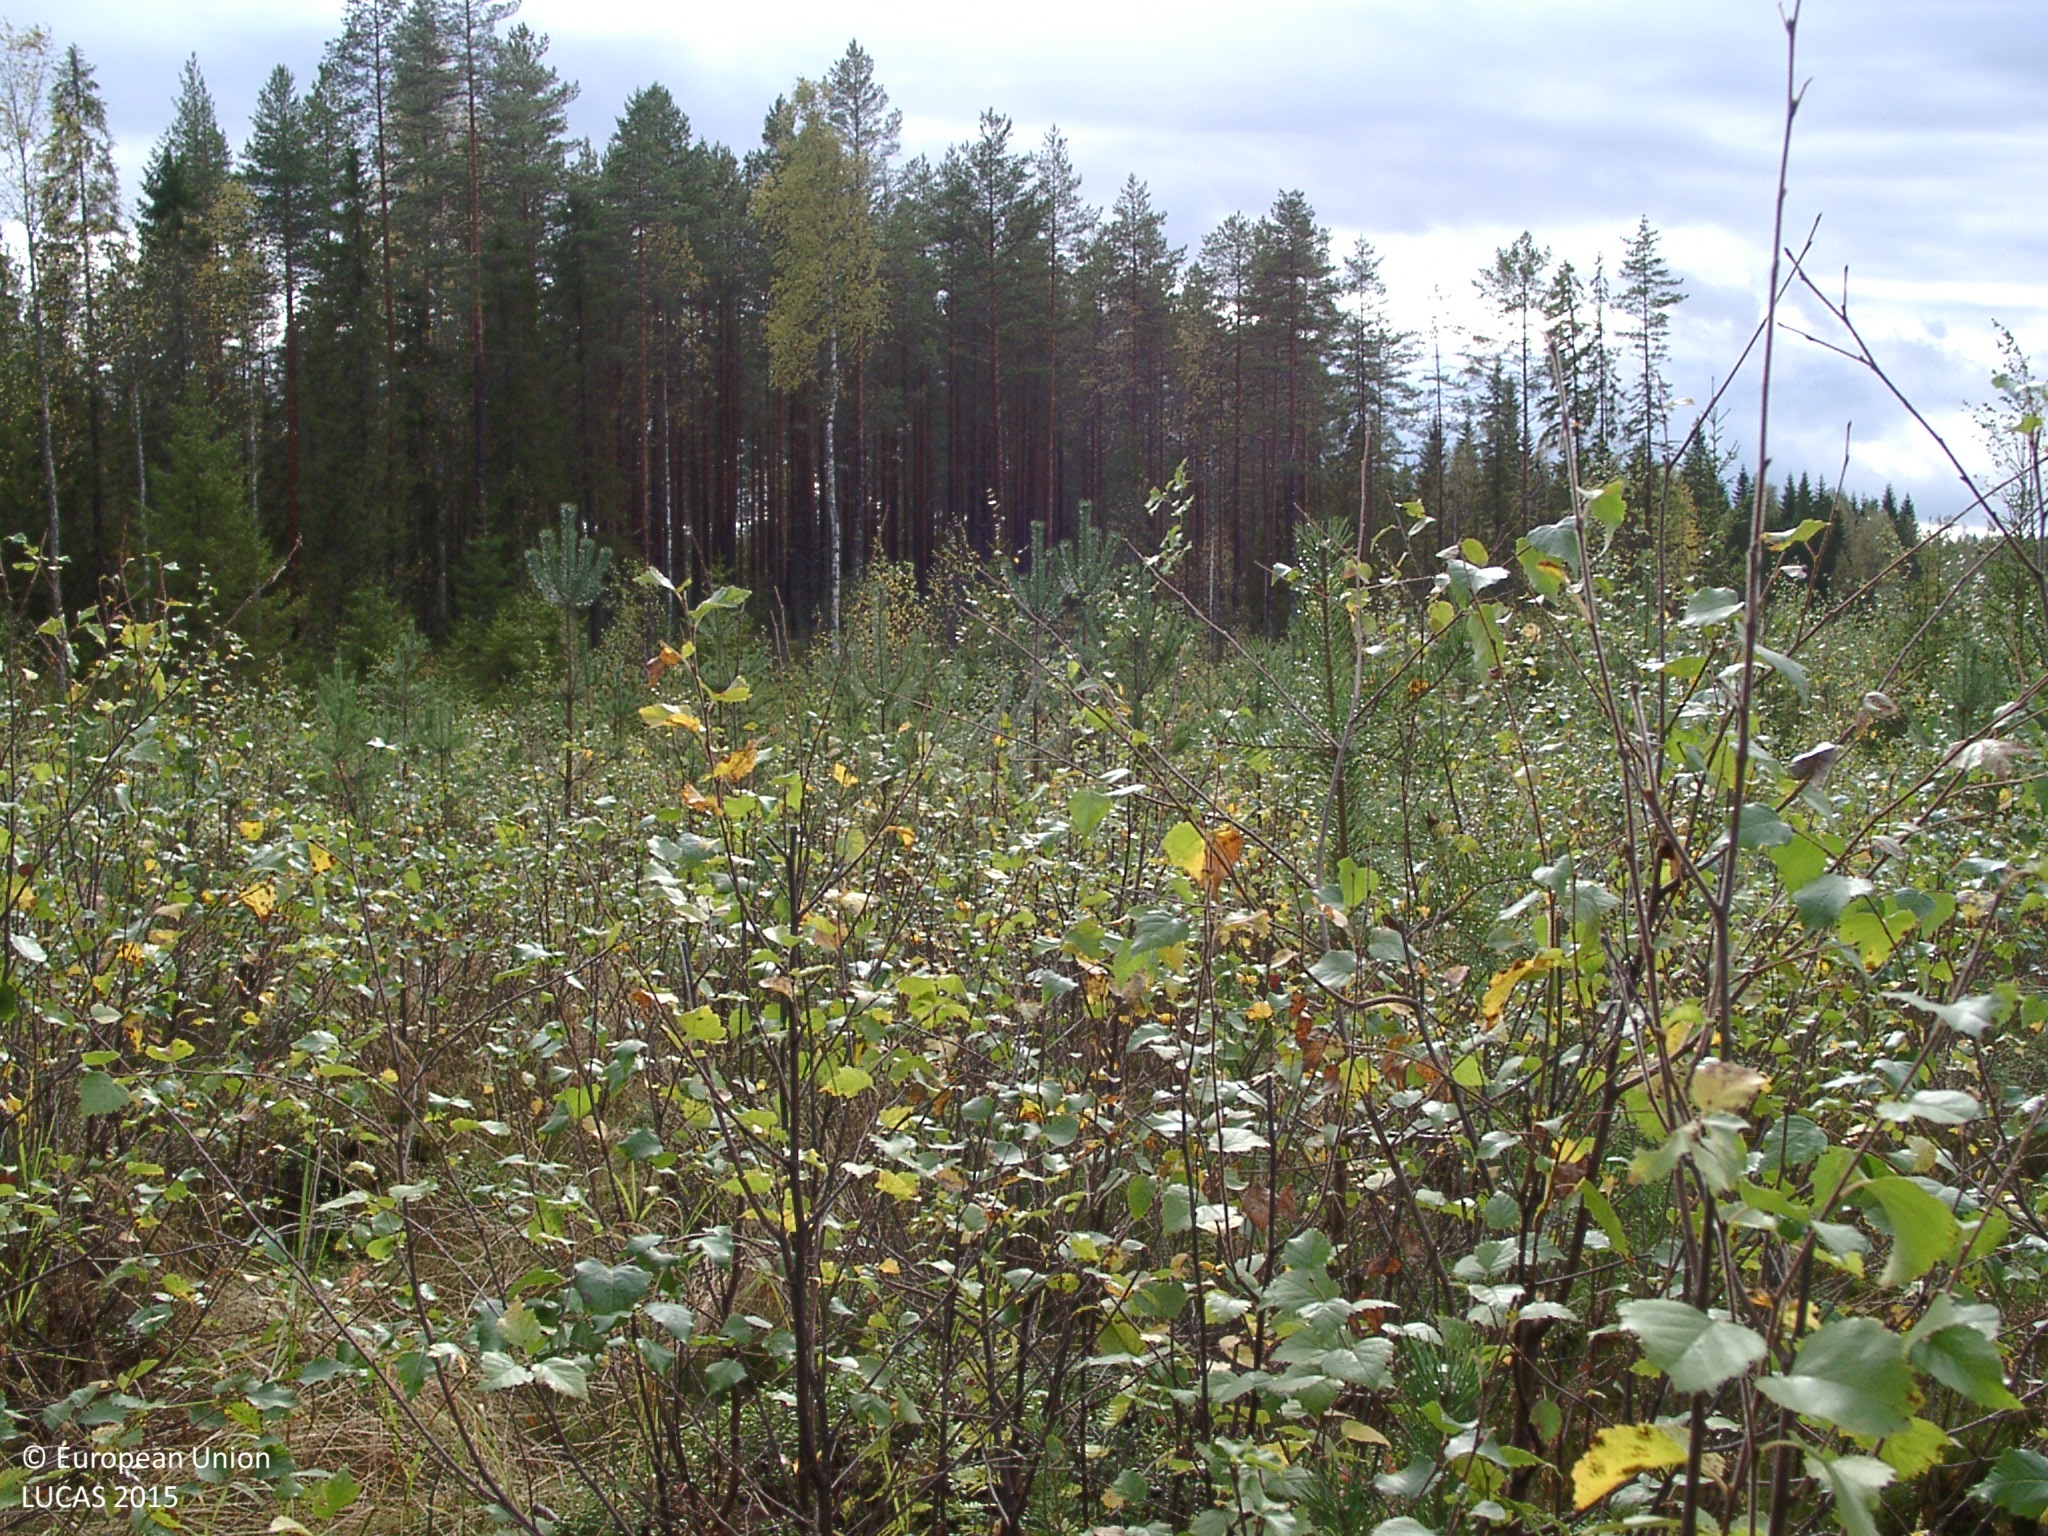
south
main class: Woodland
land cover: Pine dominated mixed woodland
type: boreal forest
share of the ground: 25 - 50 %
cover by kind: shrubs 50 %, broadleaved forest trees 20 %, coniferous forest trees 10 %, herbaceous plants 10 %, lichens and mosses 10 %
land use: Forestry
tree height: < 5 m
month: September
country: FI
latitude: 62.7221
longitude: 25.7022
